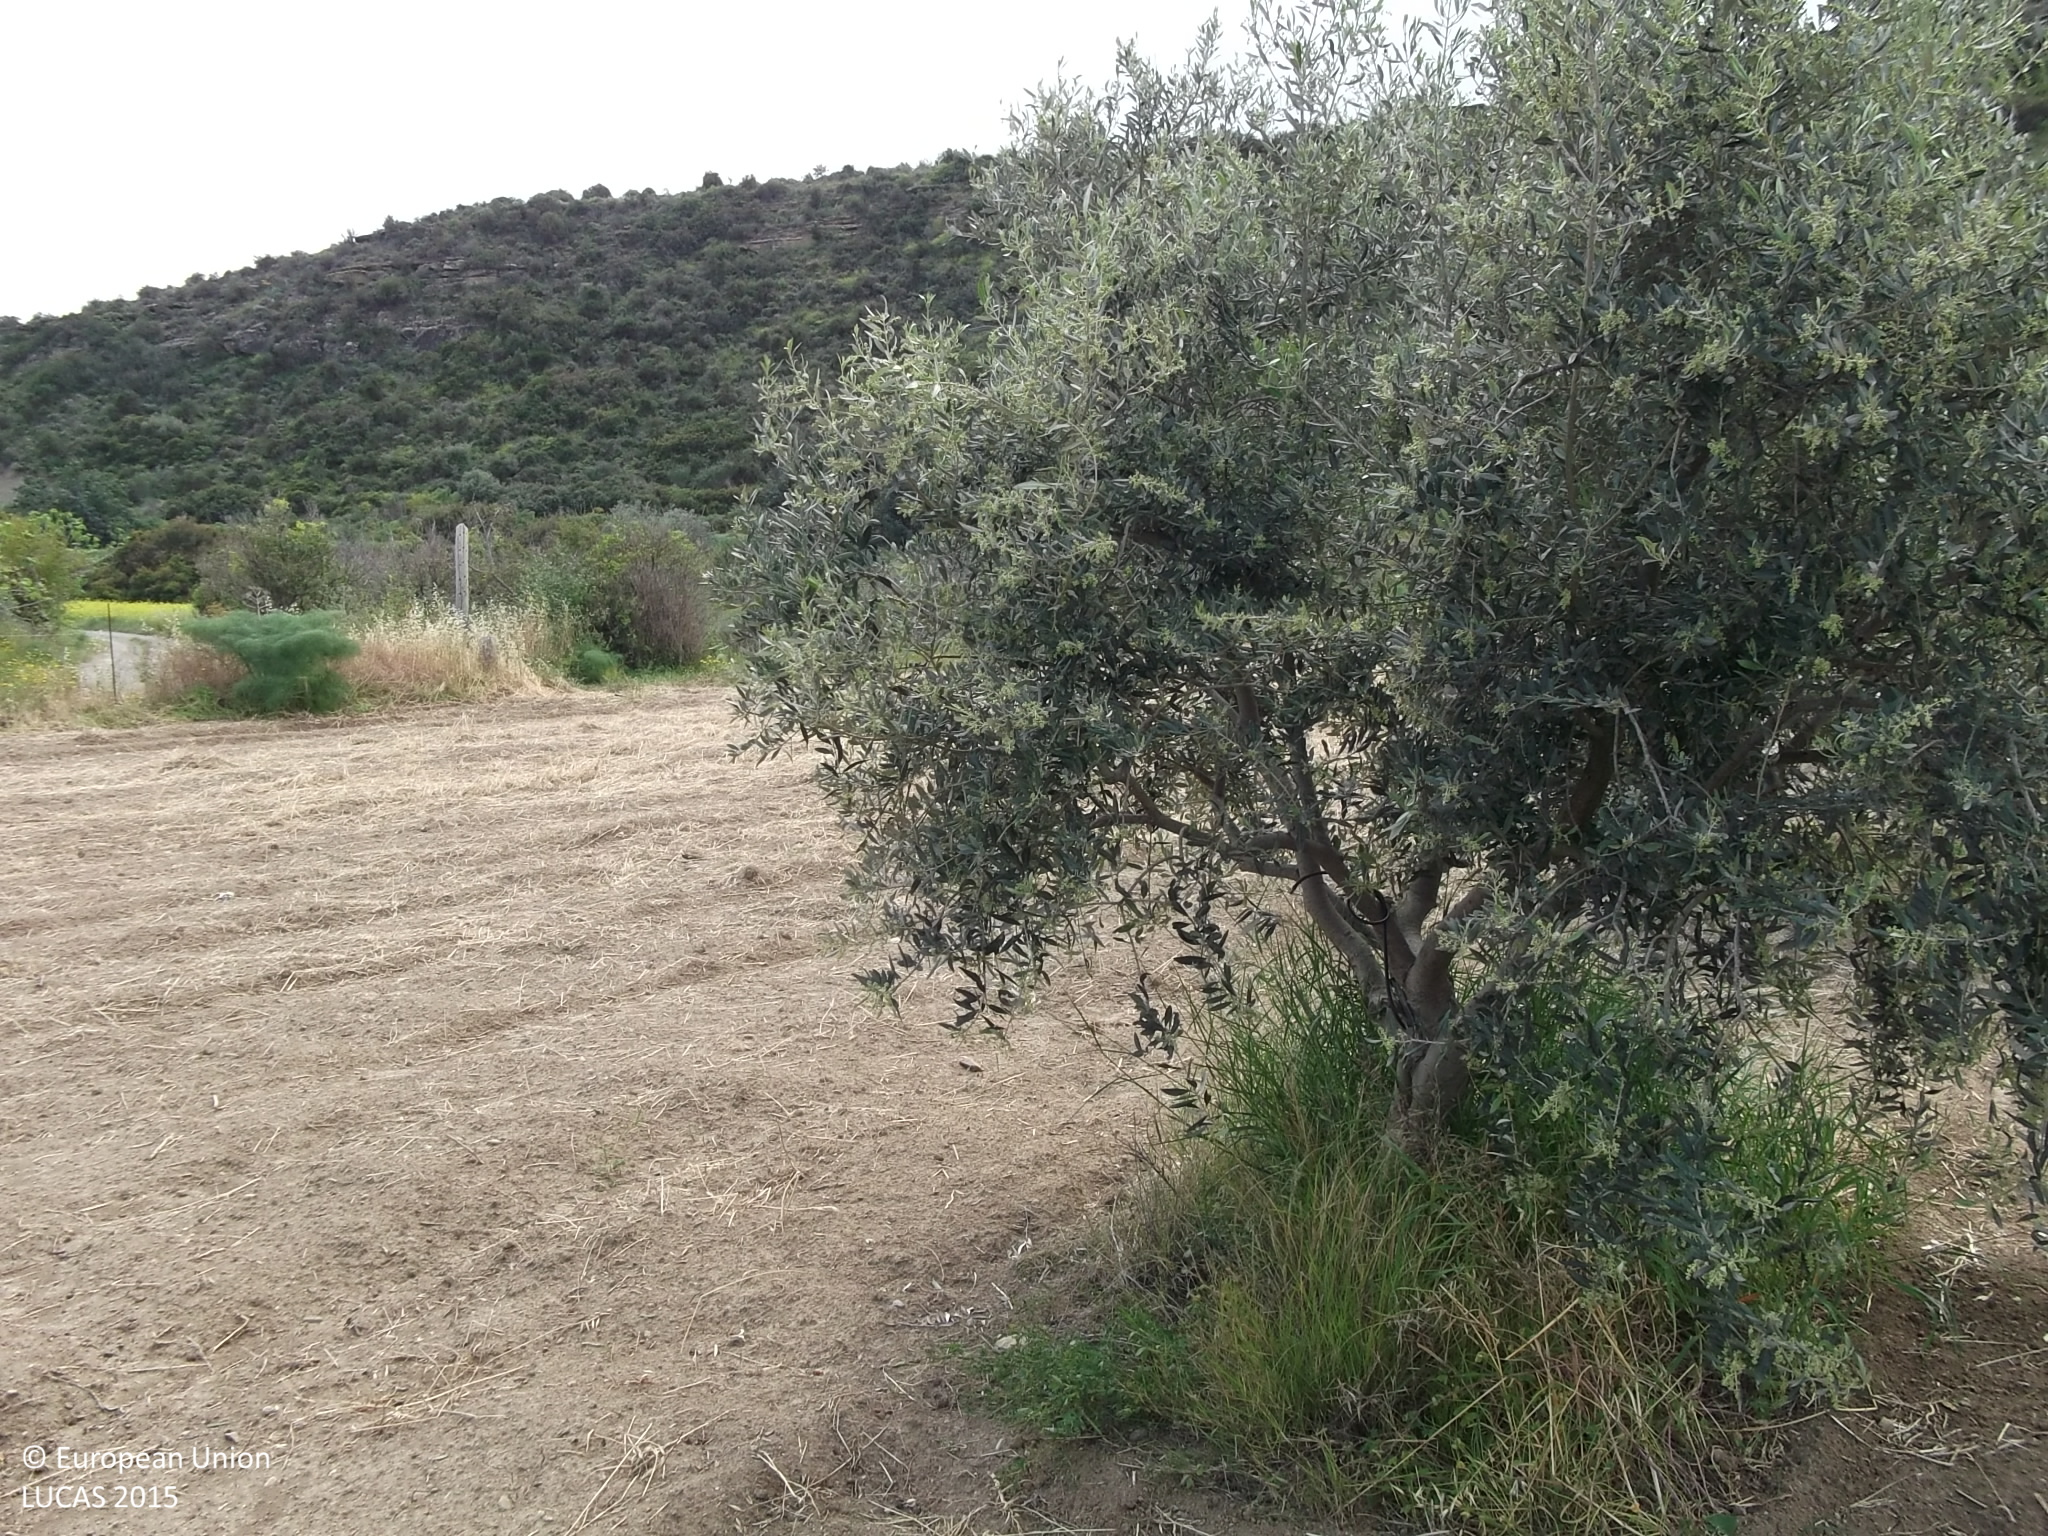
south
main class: Cropland
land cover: Olive groves
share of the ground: 25 - 50 %
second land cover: Other bare soil
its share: > 75 %
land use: Agriculture (excluding fallow land and kitchen gardens)
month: April
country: CY
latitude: 34.7660
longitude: 33.3990
